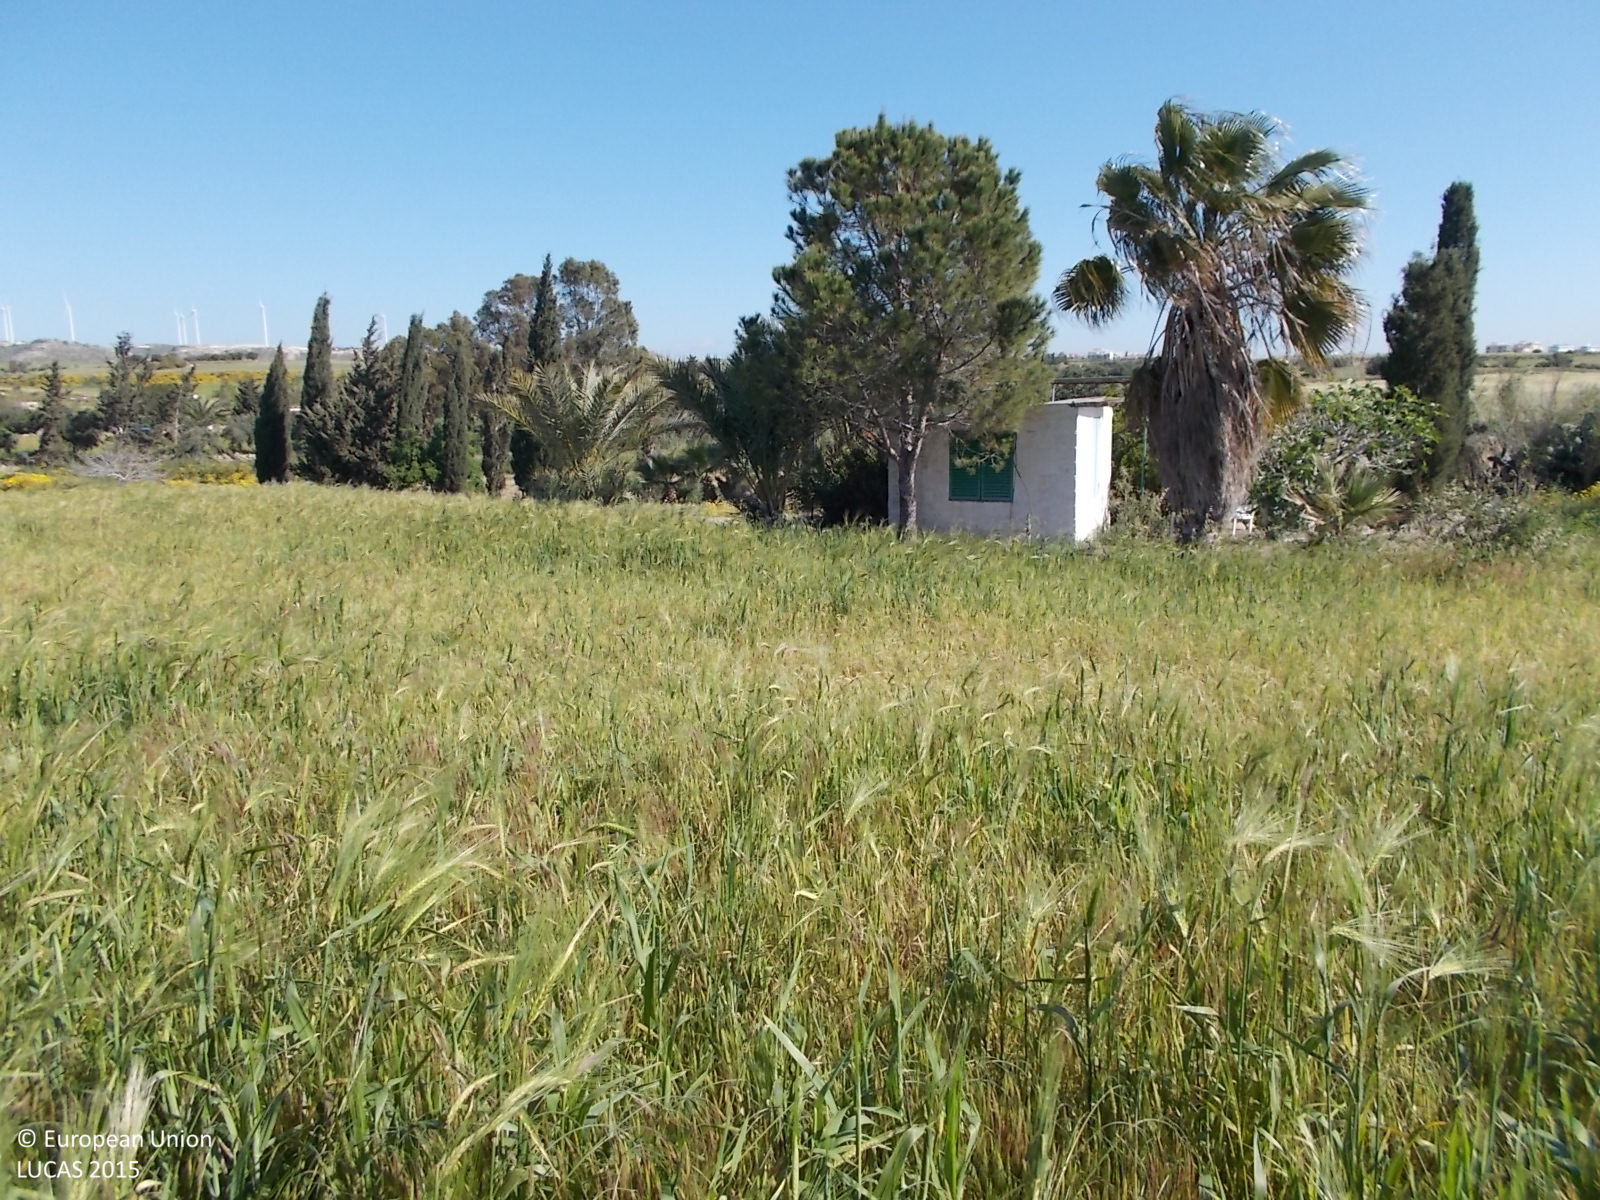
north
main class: Cropland
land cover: Common wheat
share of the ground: > 75 %
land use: Agriculture (excluding fallow land and kitchen gardens)
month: April
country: CY
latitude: 34.8424
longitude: 33.5381
